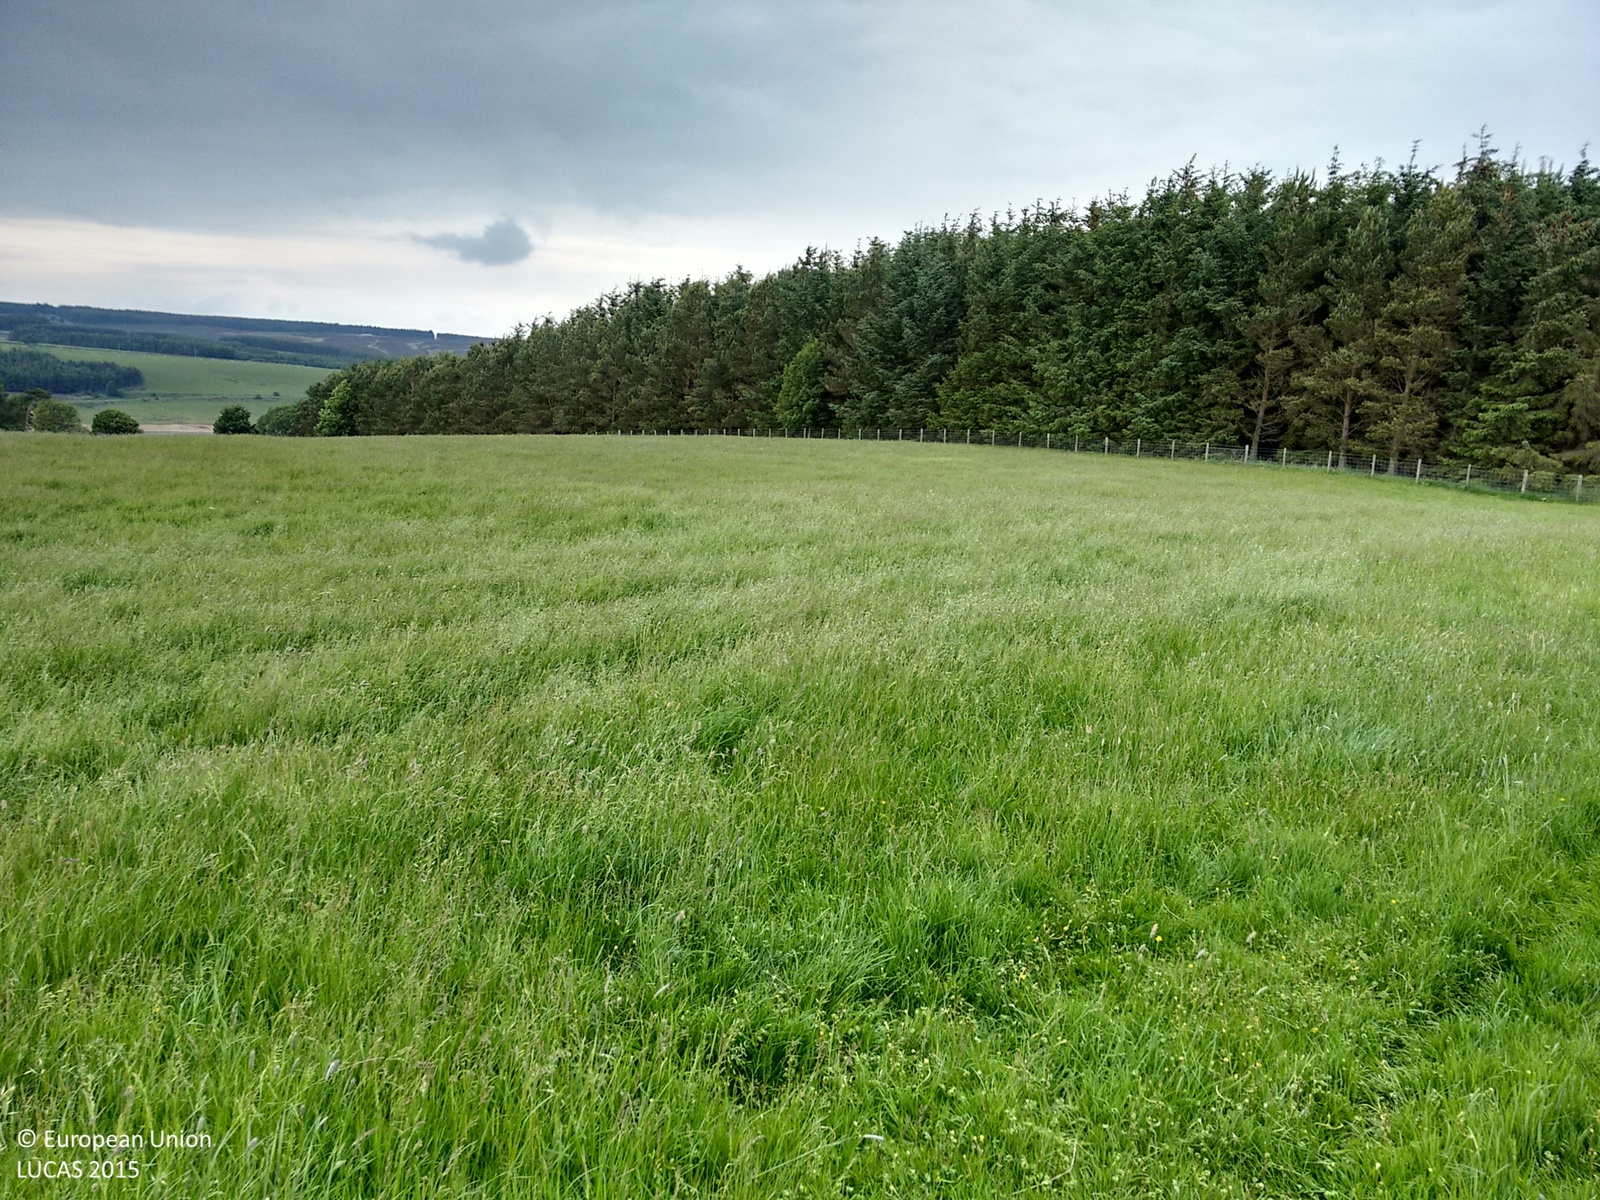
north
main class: Shrubland
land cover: Shrubland without tree cover
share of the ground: > 75 %
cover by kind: shrubs 90 %, herbaceous plants 10 %
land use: Agriculture (excluding fallow land and kitchen gardens)
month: June
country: GB
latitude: 54.8576
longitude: -2.0032
